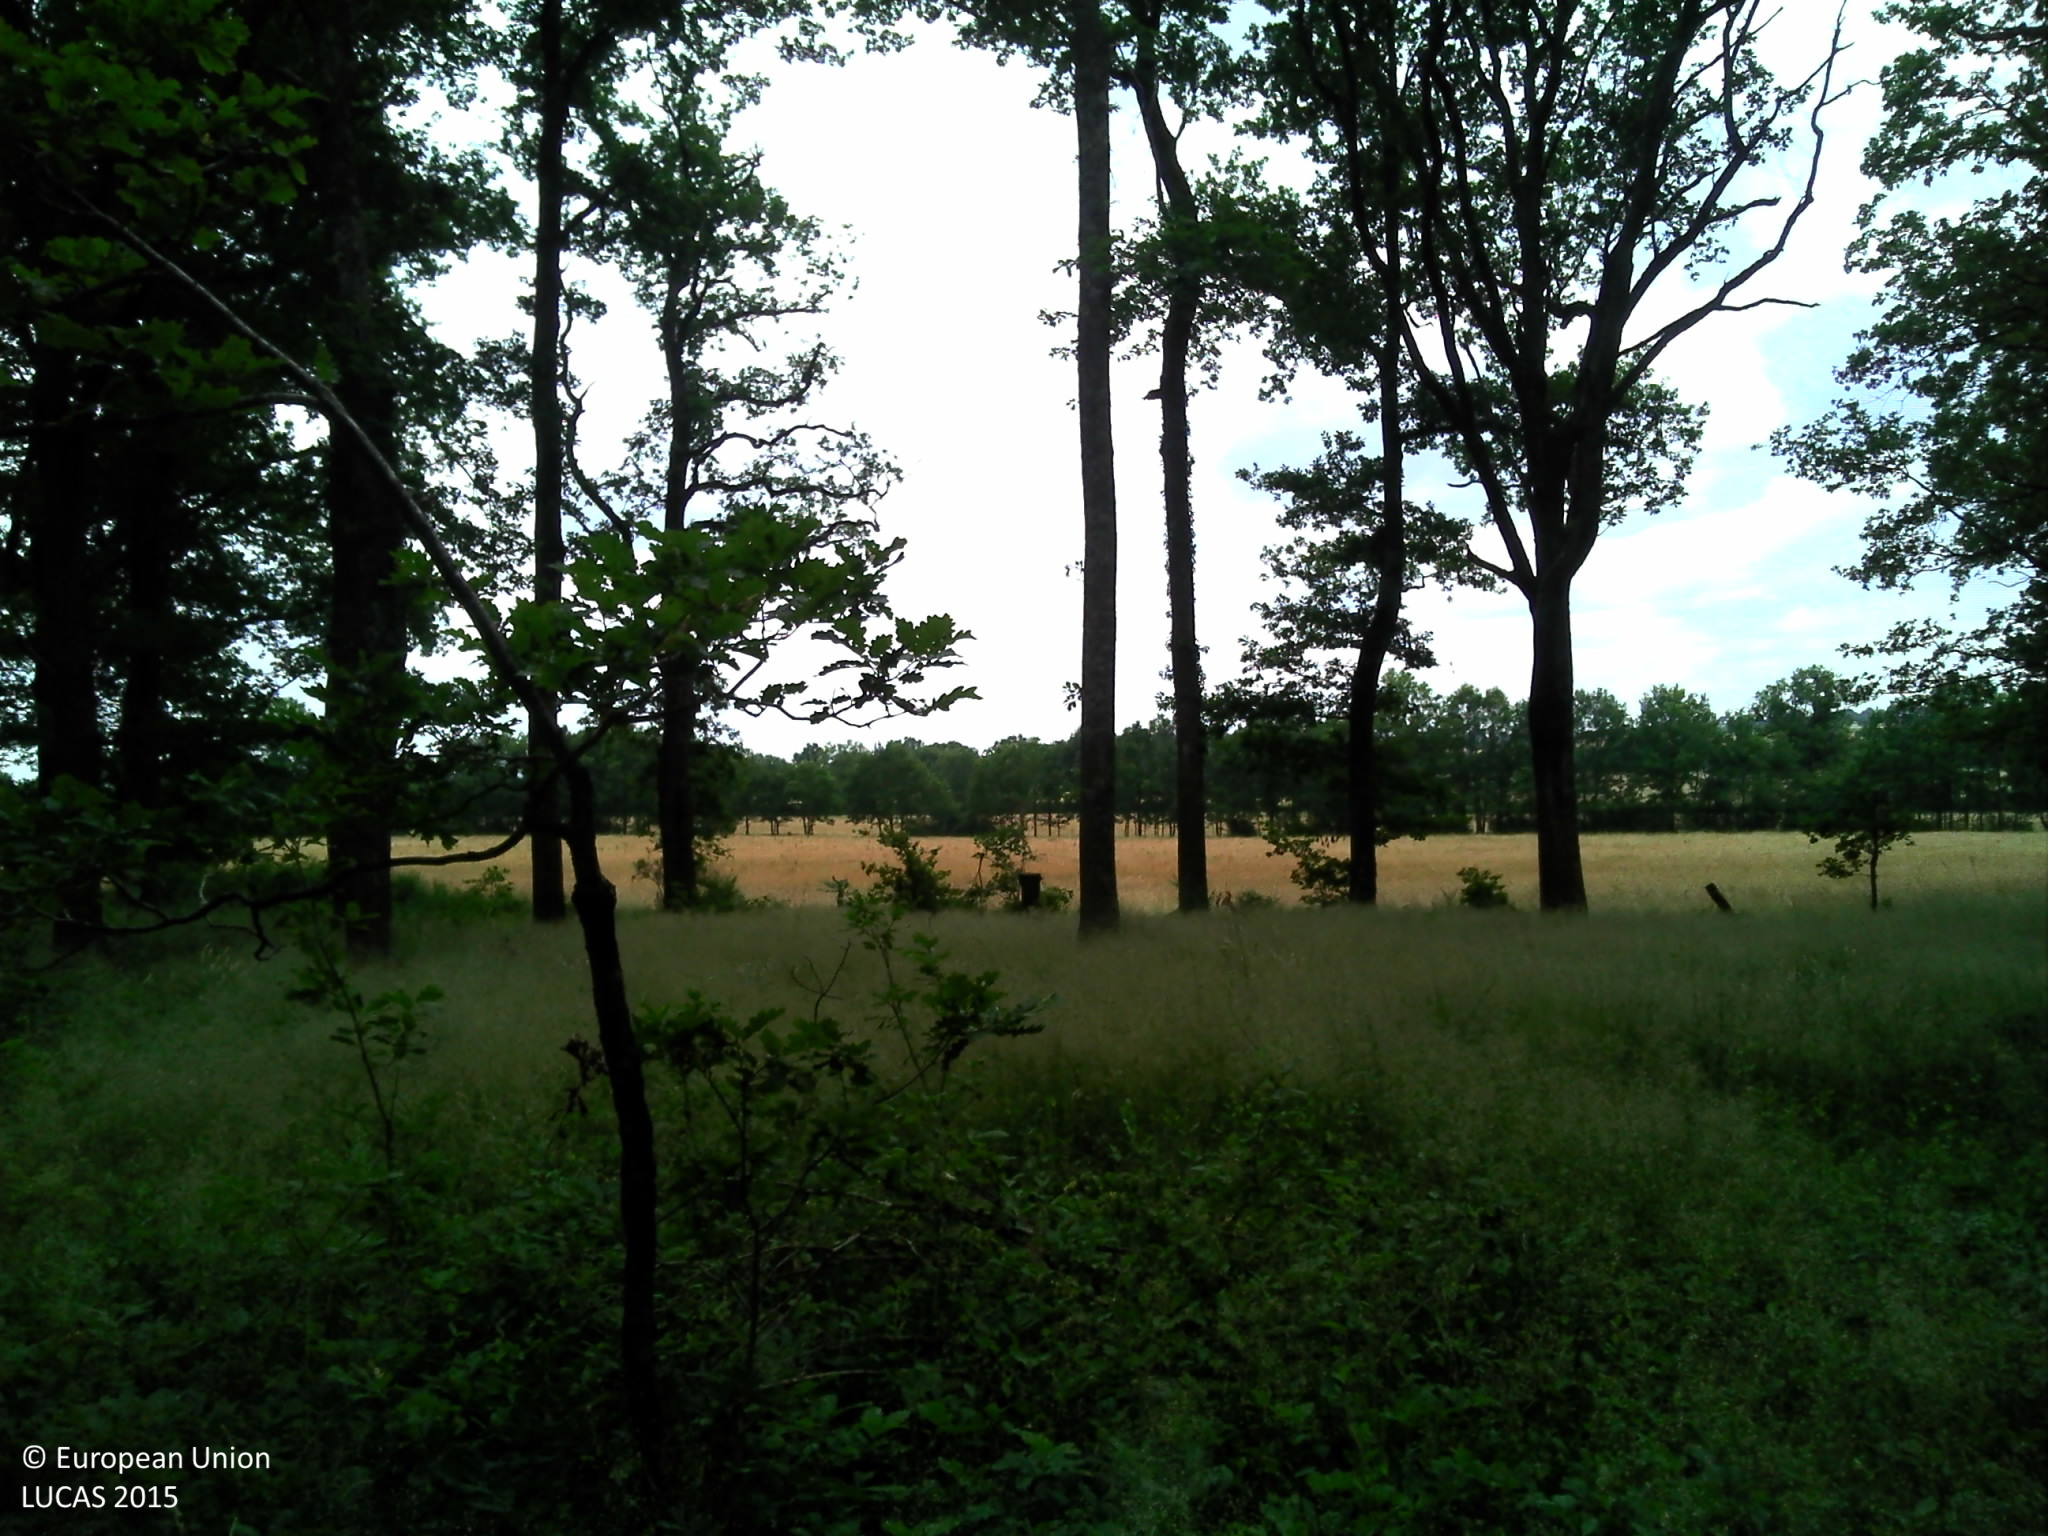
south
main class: Woodland
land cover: Broadleaved woodland
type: acidophilous oak and oak-birch forest
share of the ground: > 75 %
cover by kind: broadleaved forest trees 90 %, herbaceous plants 10 %
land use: Forestry
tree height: > 5 m
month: June
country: FR
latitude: 46.3962
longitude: 2.7785
